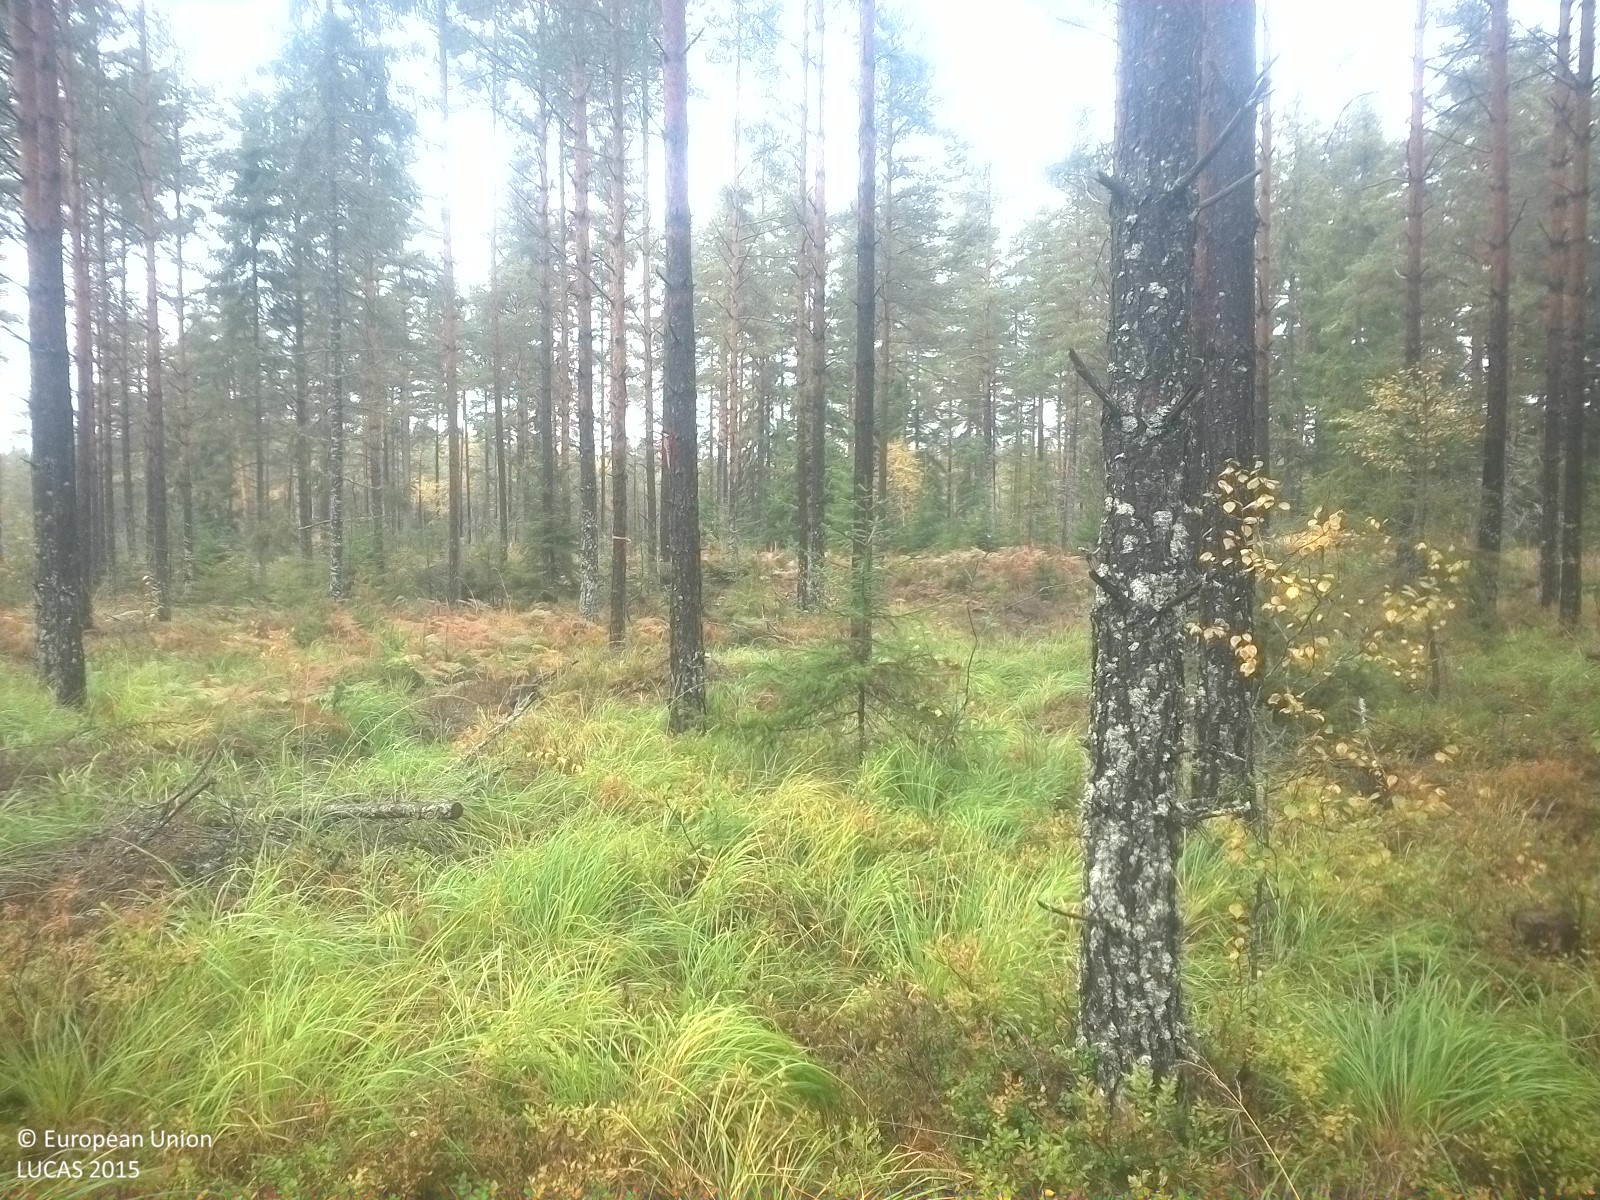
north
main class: Woodland
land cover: Pine dominated coniferous woodland
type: boreal forest
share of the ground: 25 - 50 %
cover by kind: herbaceous plants 50 %, coniferous forest trees 30 %, lichens and mosses 10 %, broadleaved forest trees 5 %, shrubs 5 %
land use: Forestry
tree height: > 5 m
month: September
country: SE
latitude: 58.8323
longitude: 16.2481
